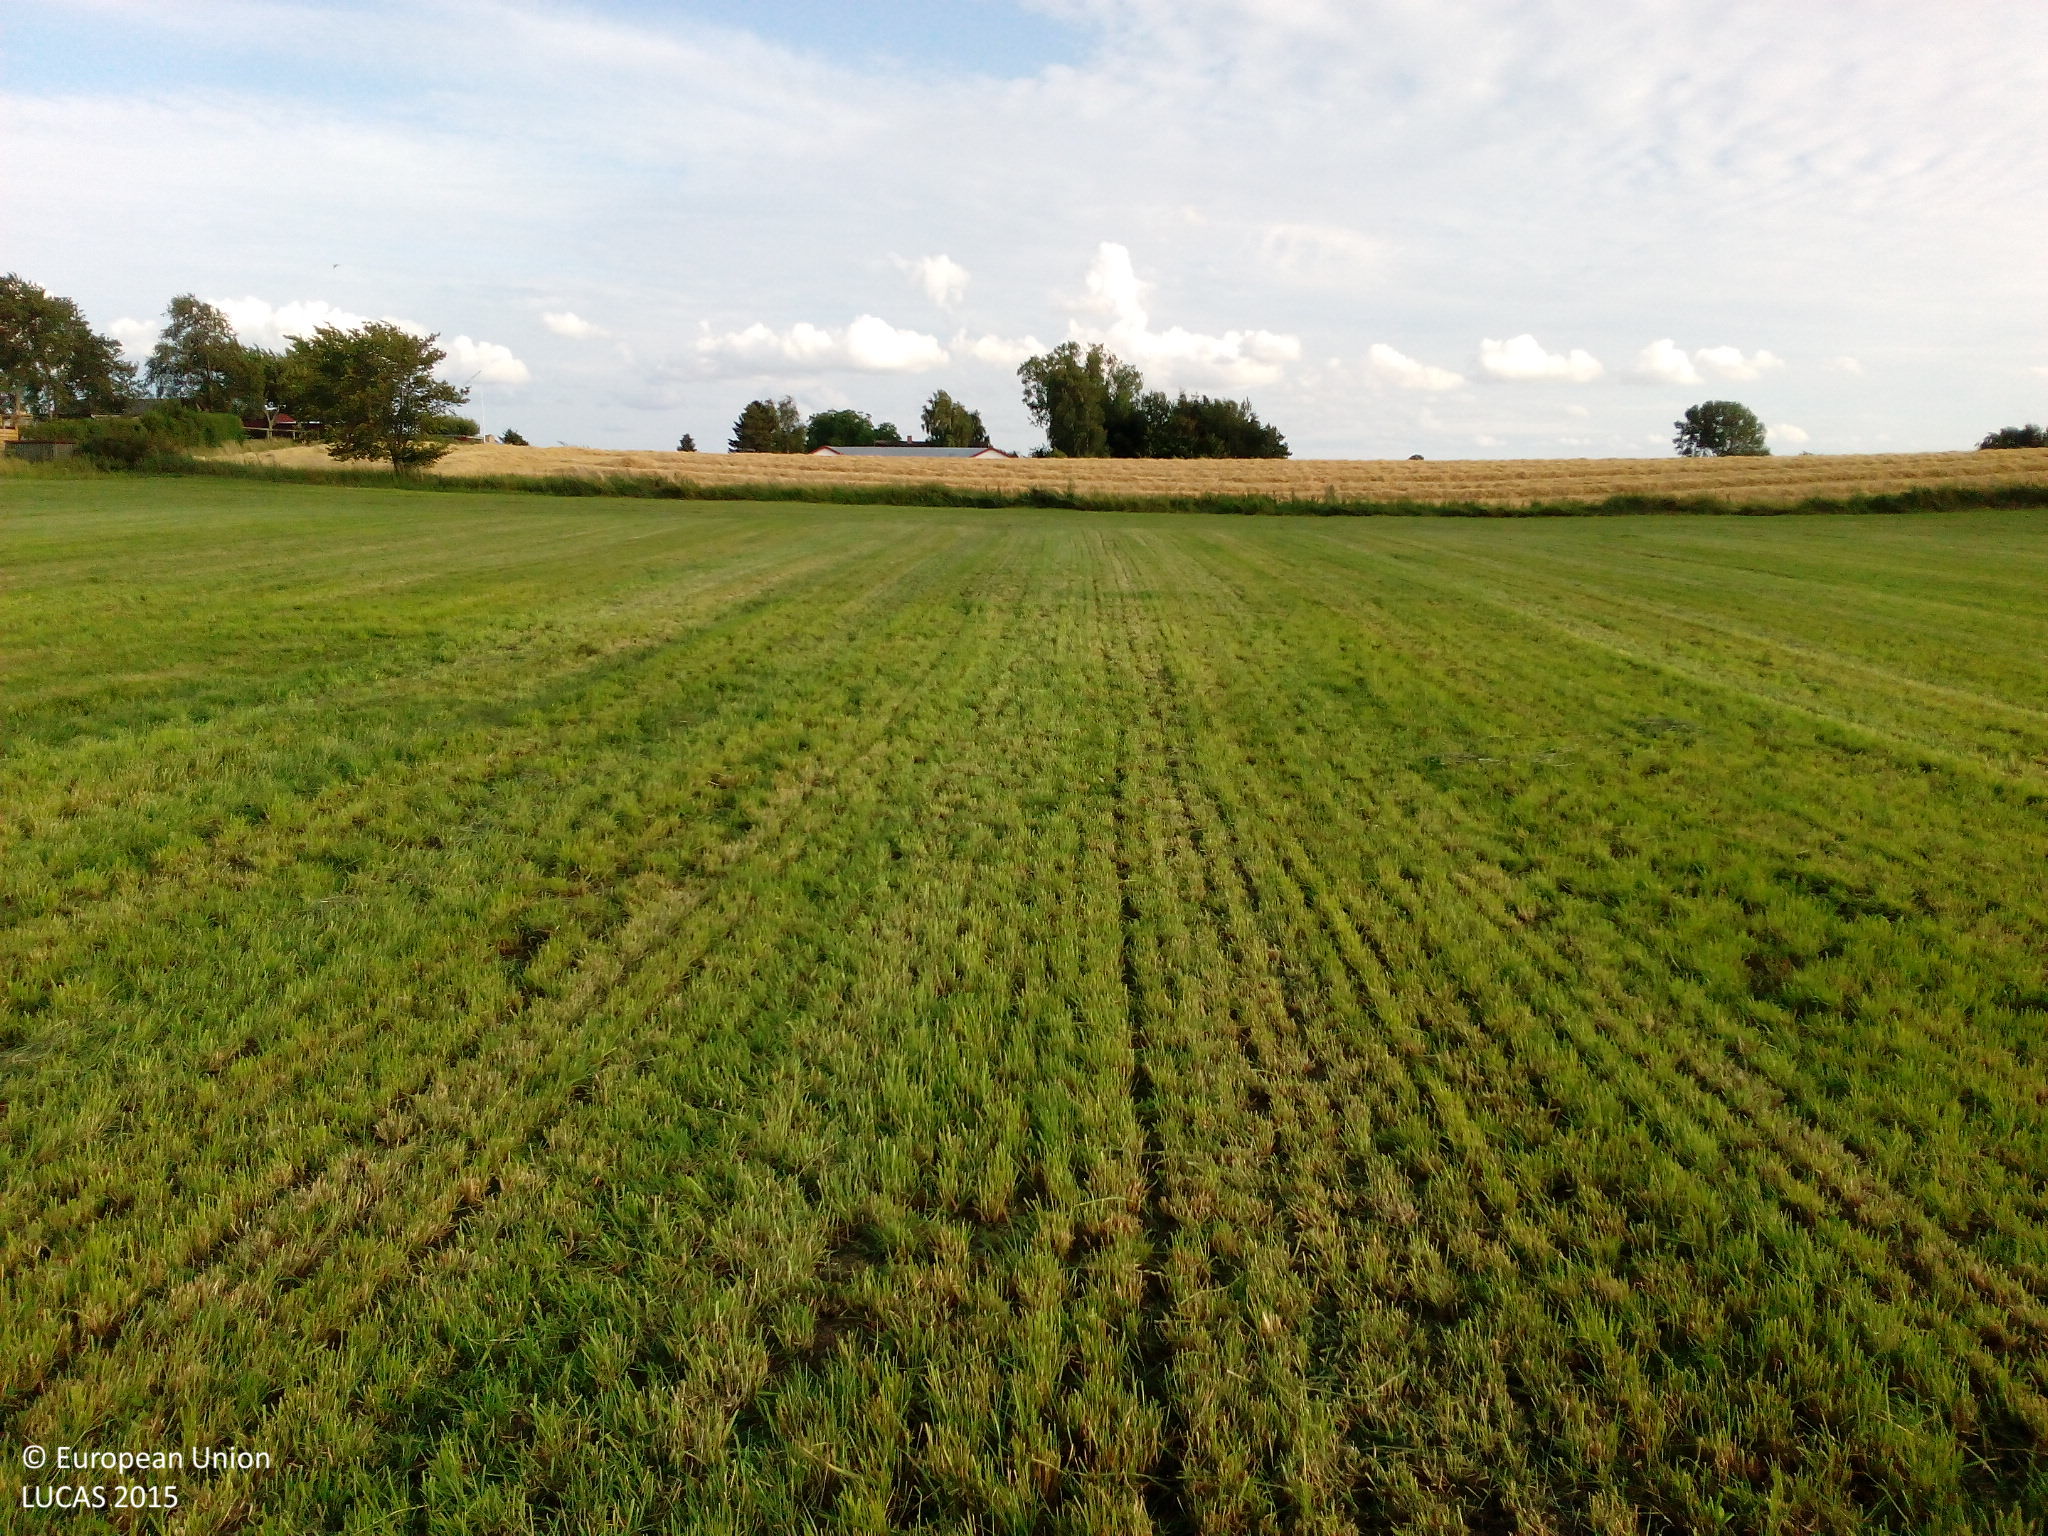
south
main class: Grassland
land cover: Grassland without tree/shrub cover
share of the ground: > 75 %
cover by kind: herbaceous plants 100 %
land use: Agriculture (excluding fallow land and kitchen gardens)
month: July
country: DK
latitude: 55.9358
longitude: 12.1591
